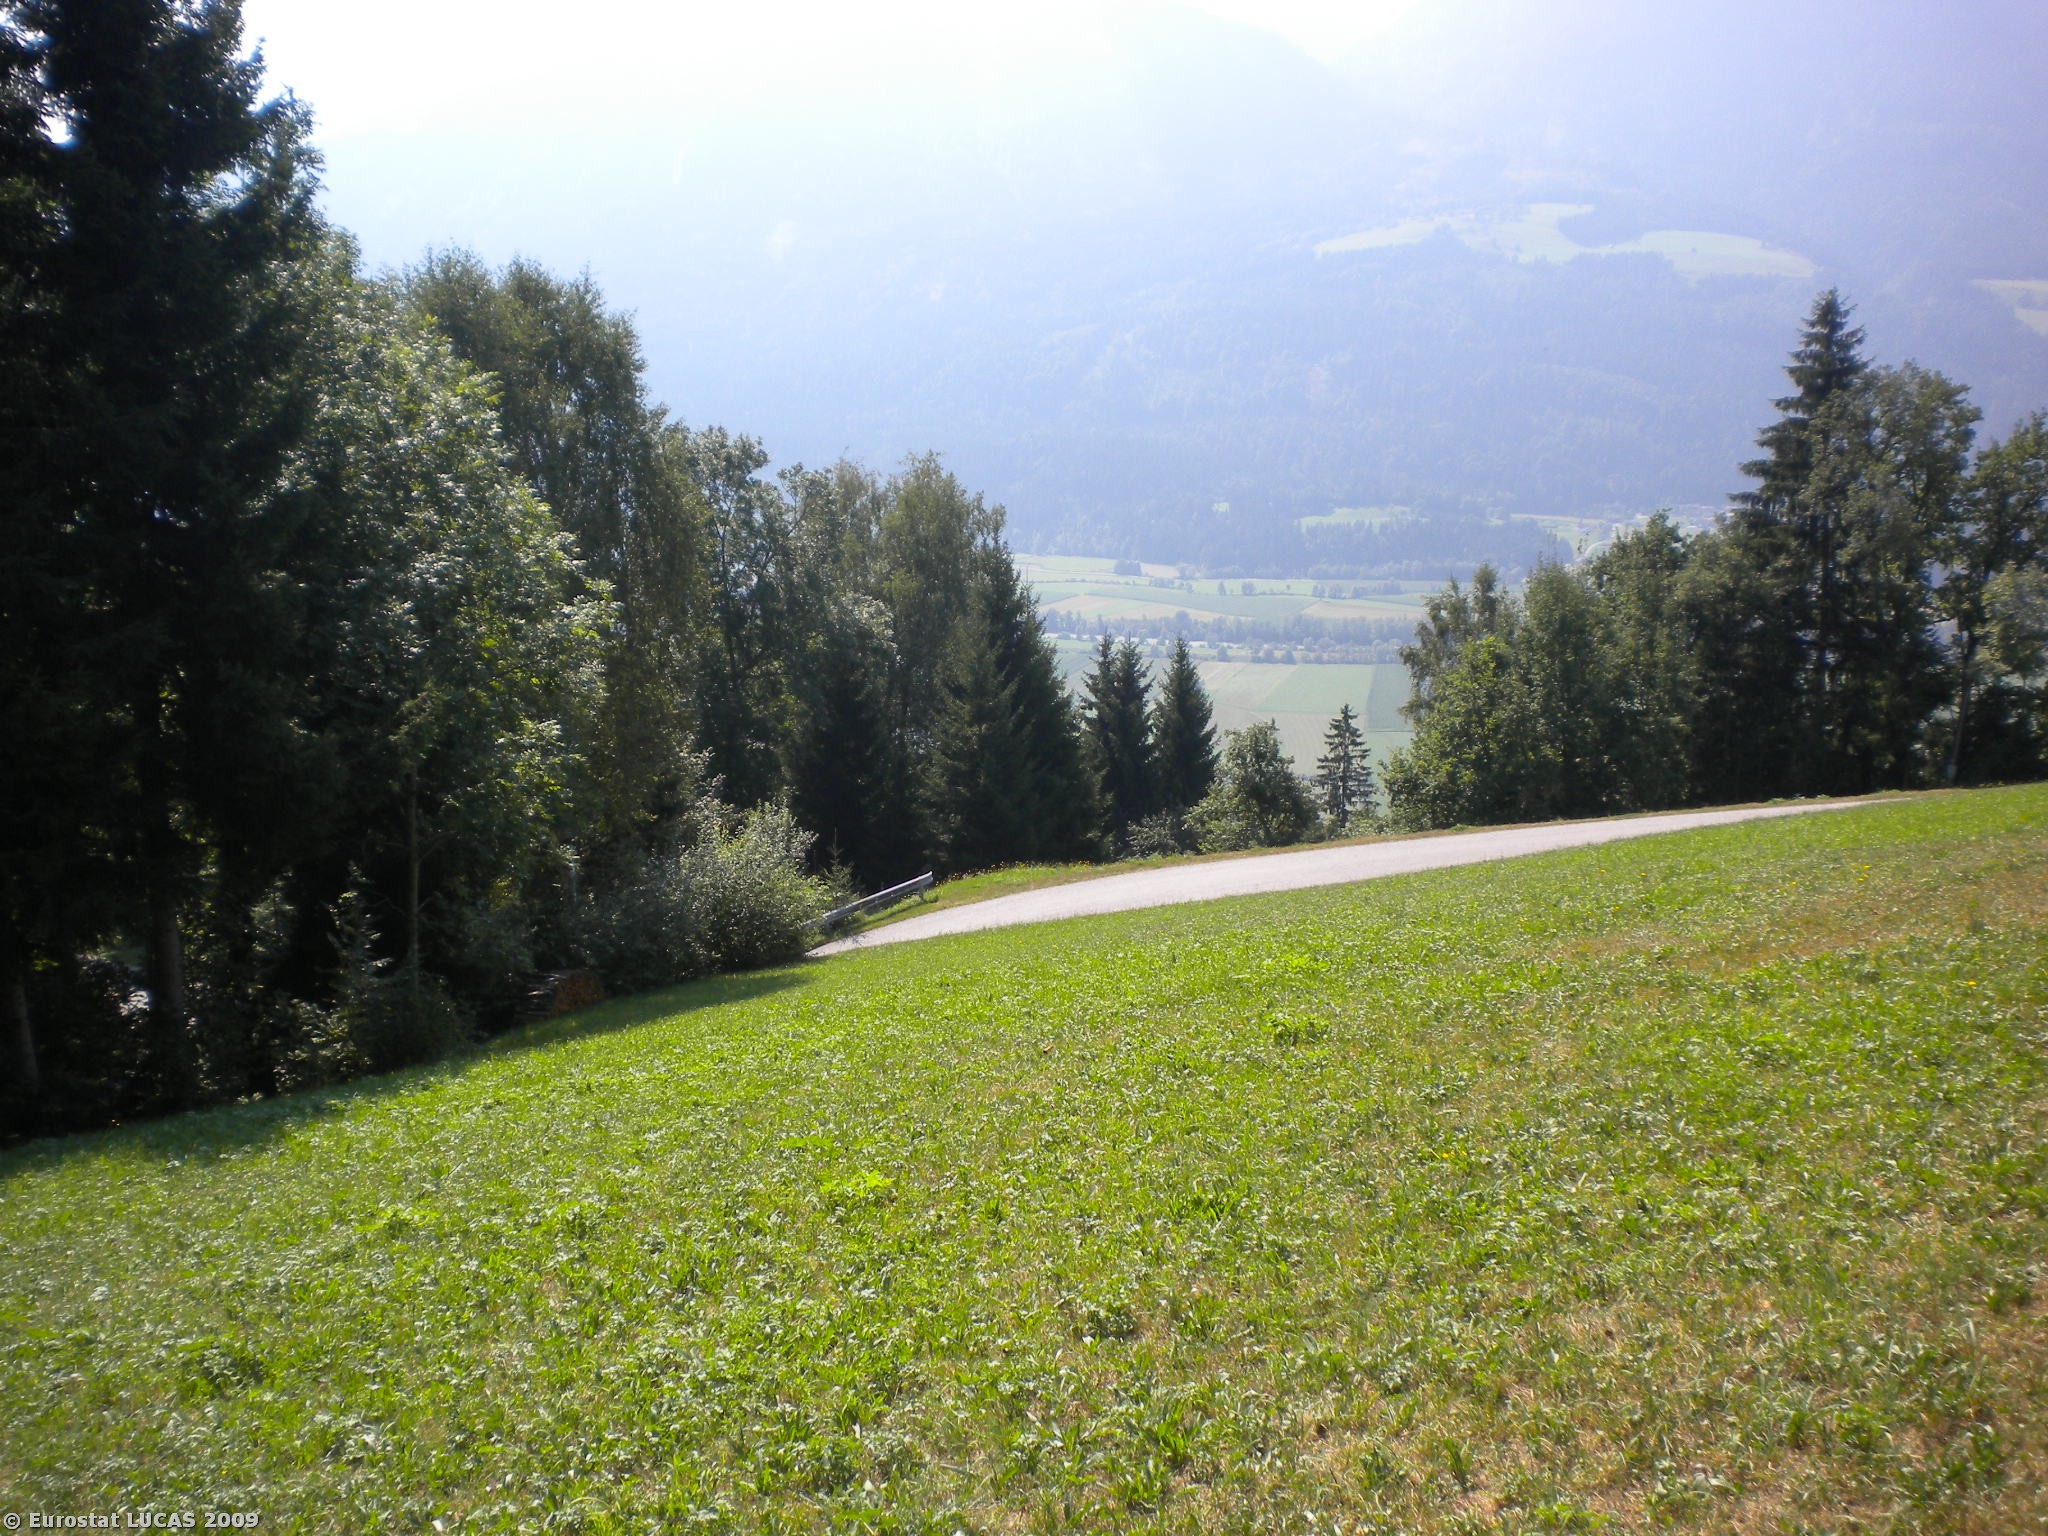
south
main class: Grassland
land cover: Grassland without tree/shrub cover
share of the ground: > 75 %
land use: Agriculture (excluding fallow land and kitchen gardens)
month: August
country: AT
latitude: 46.7554
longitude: 13.1524
